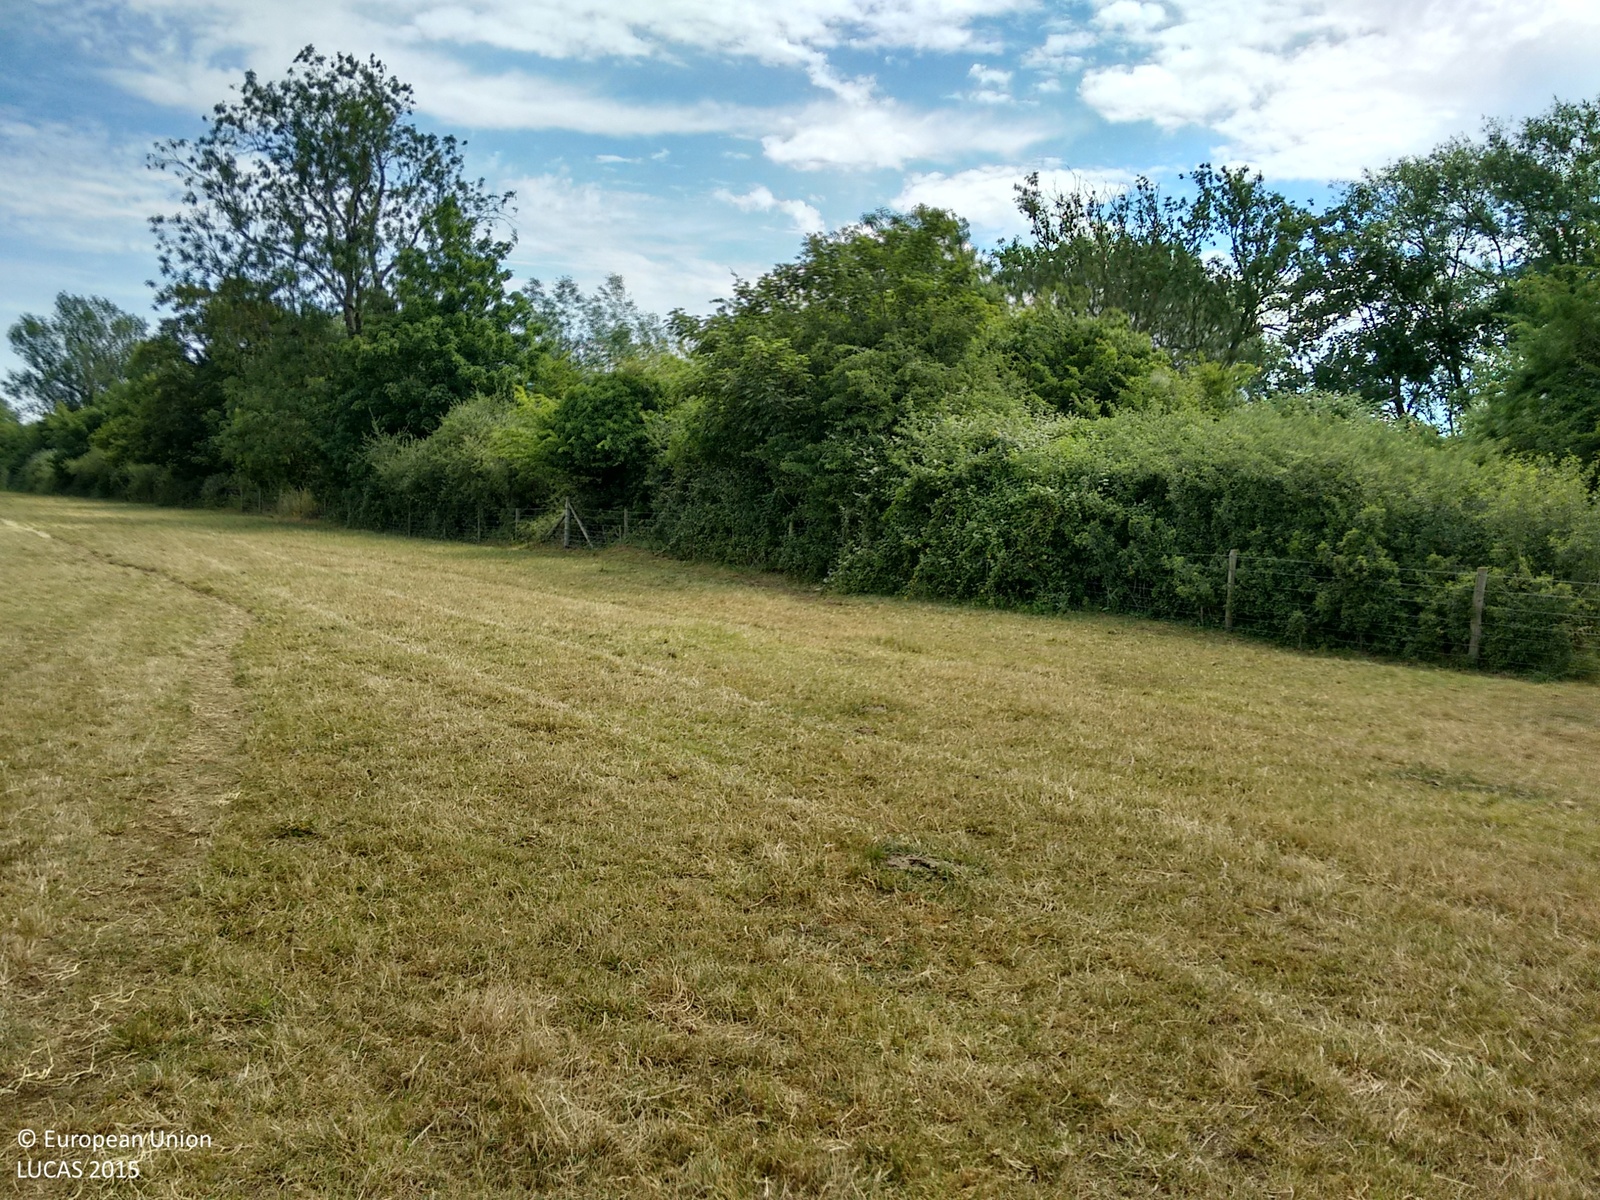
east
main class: Grassland
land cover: Grassland without tree/shrub cover
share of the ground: > 75 %
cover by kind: herbaceous plants 100 %
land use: Agriculture (excluding fallow land and kitchen gardens)
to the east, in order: Grassland without tree/shrub cover; Fences; Abandoned hedges; Tracks; Abandoned hedges; Inland fresh water bodies; Groves; Grassland without tree/shrub cover
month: July
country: GB
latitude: 51.6441
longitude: -1.2181
